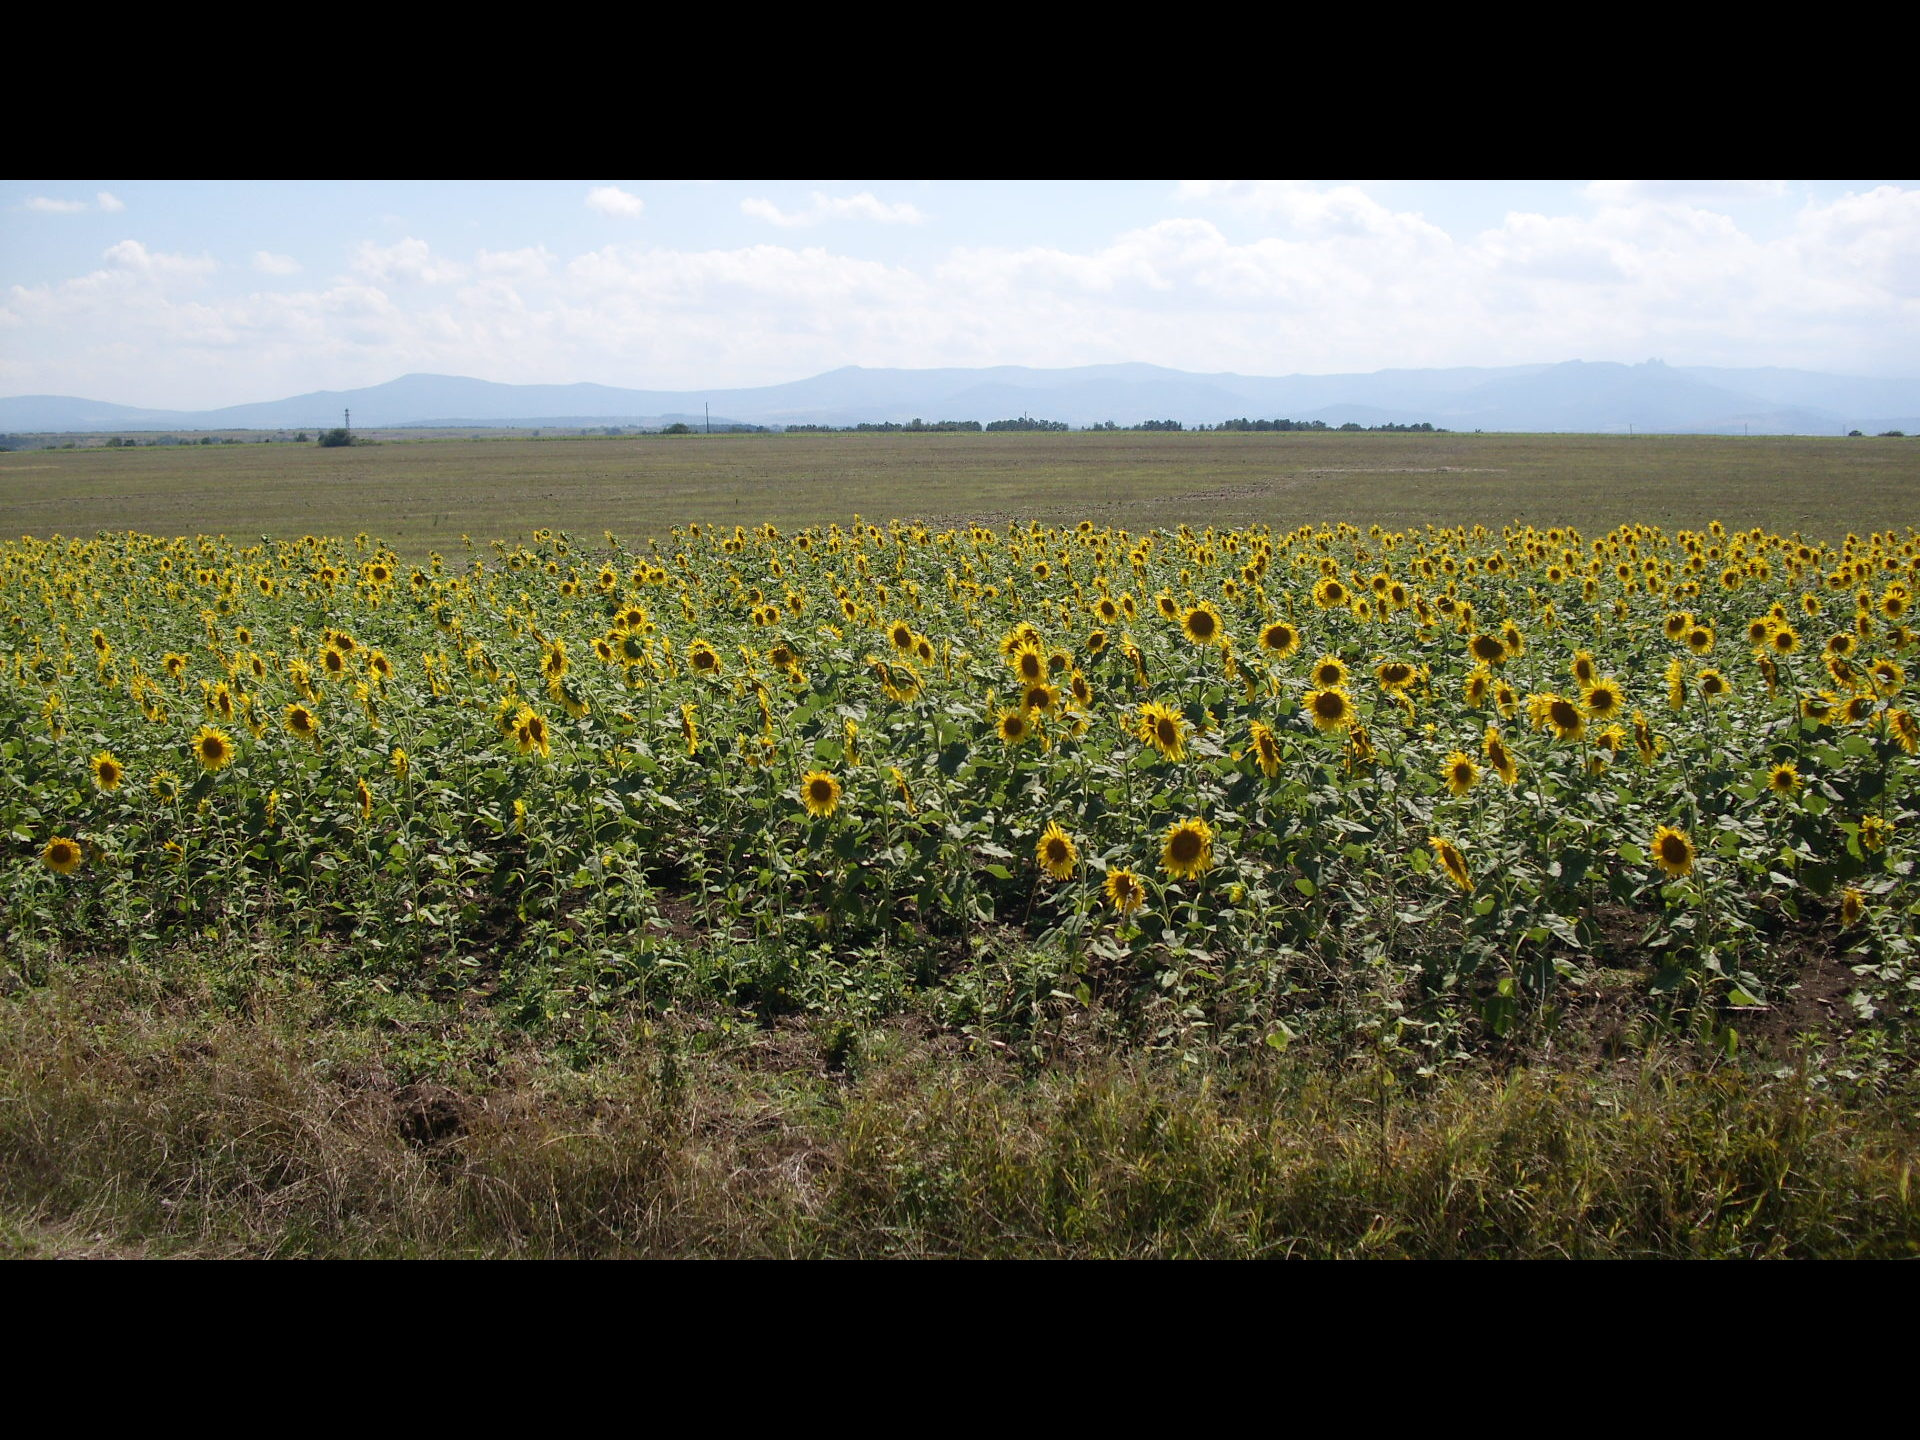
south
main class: Cropland
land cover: Sunflower
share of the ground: > 75 %
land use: Agriculture (excluding fallow land and kitchen gardens)
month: August
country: BG
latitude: 43.6216
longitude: 22.9881
